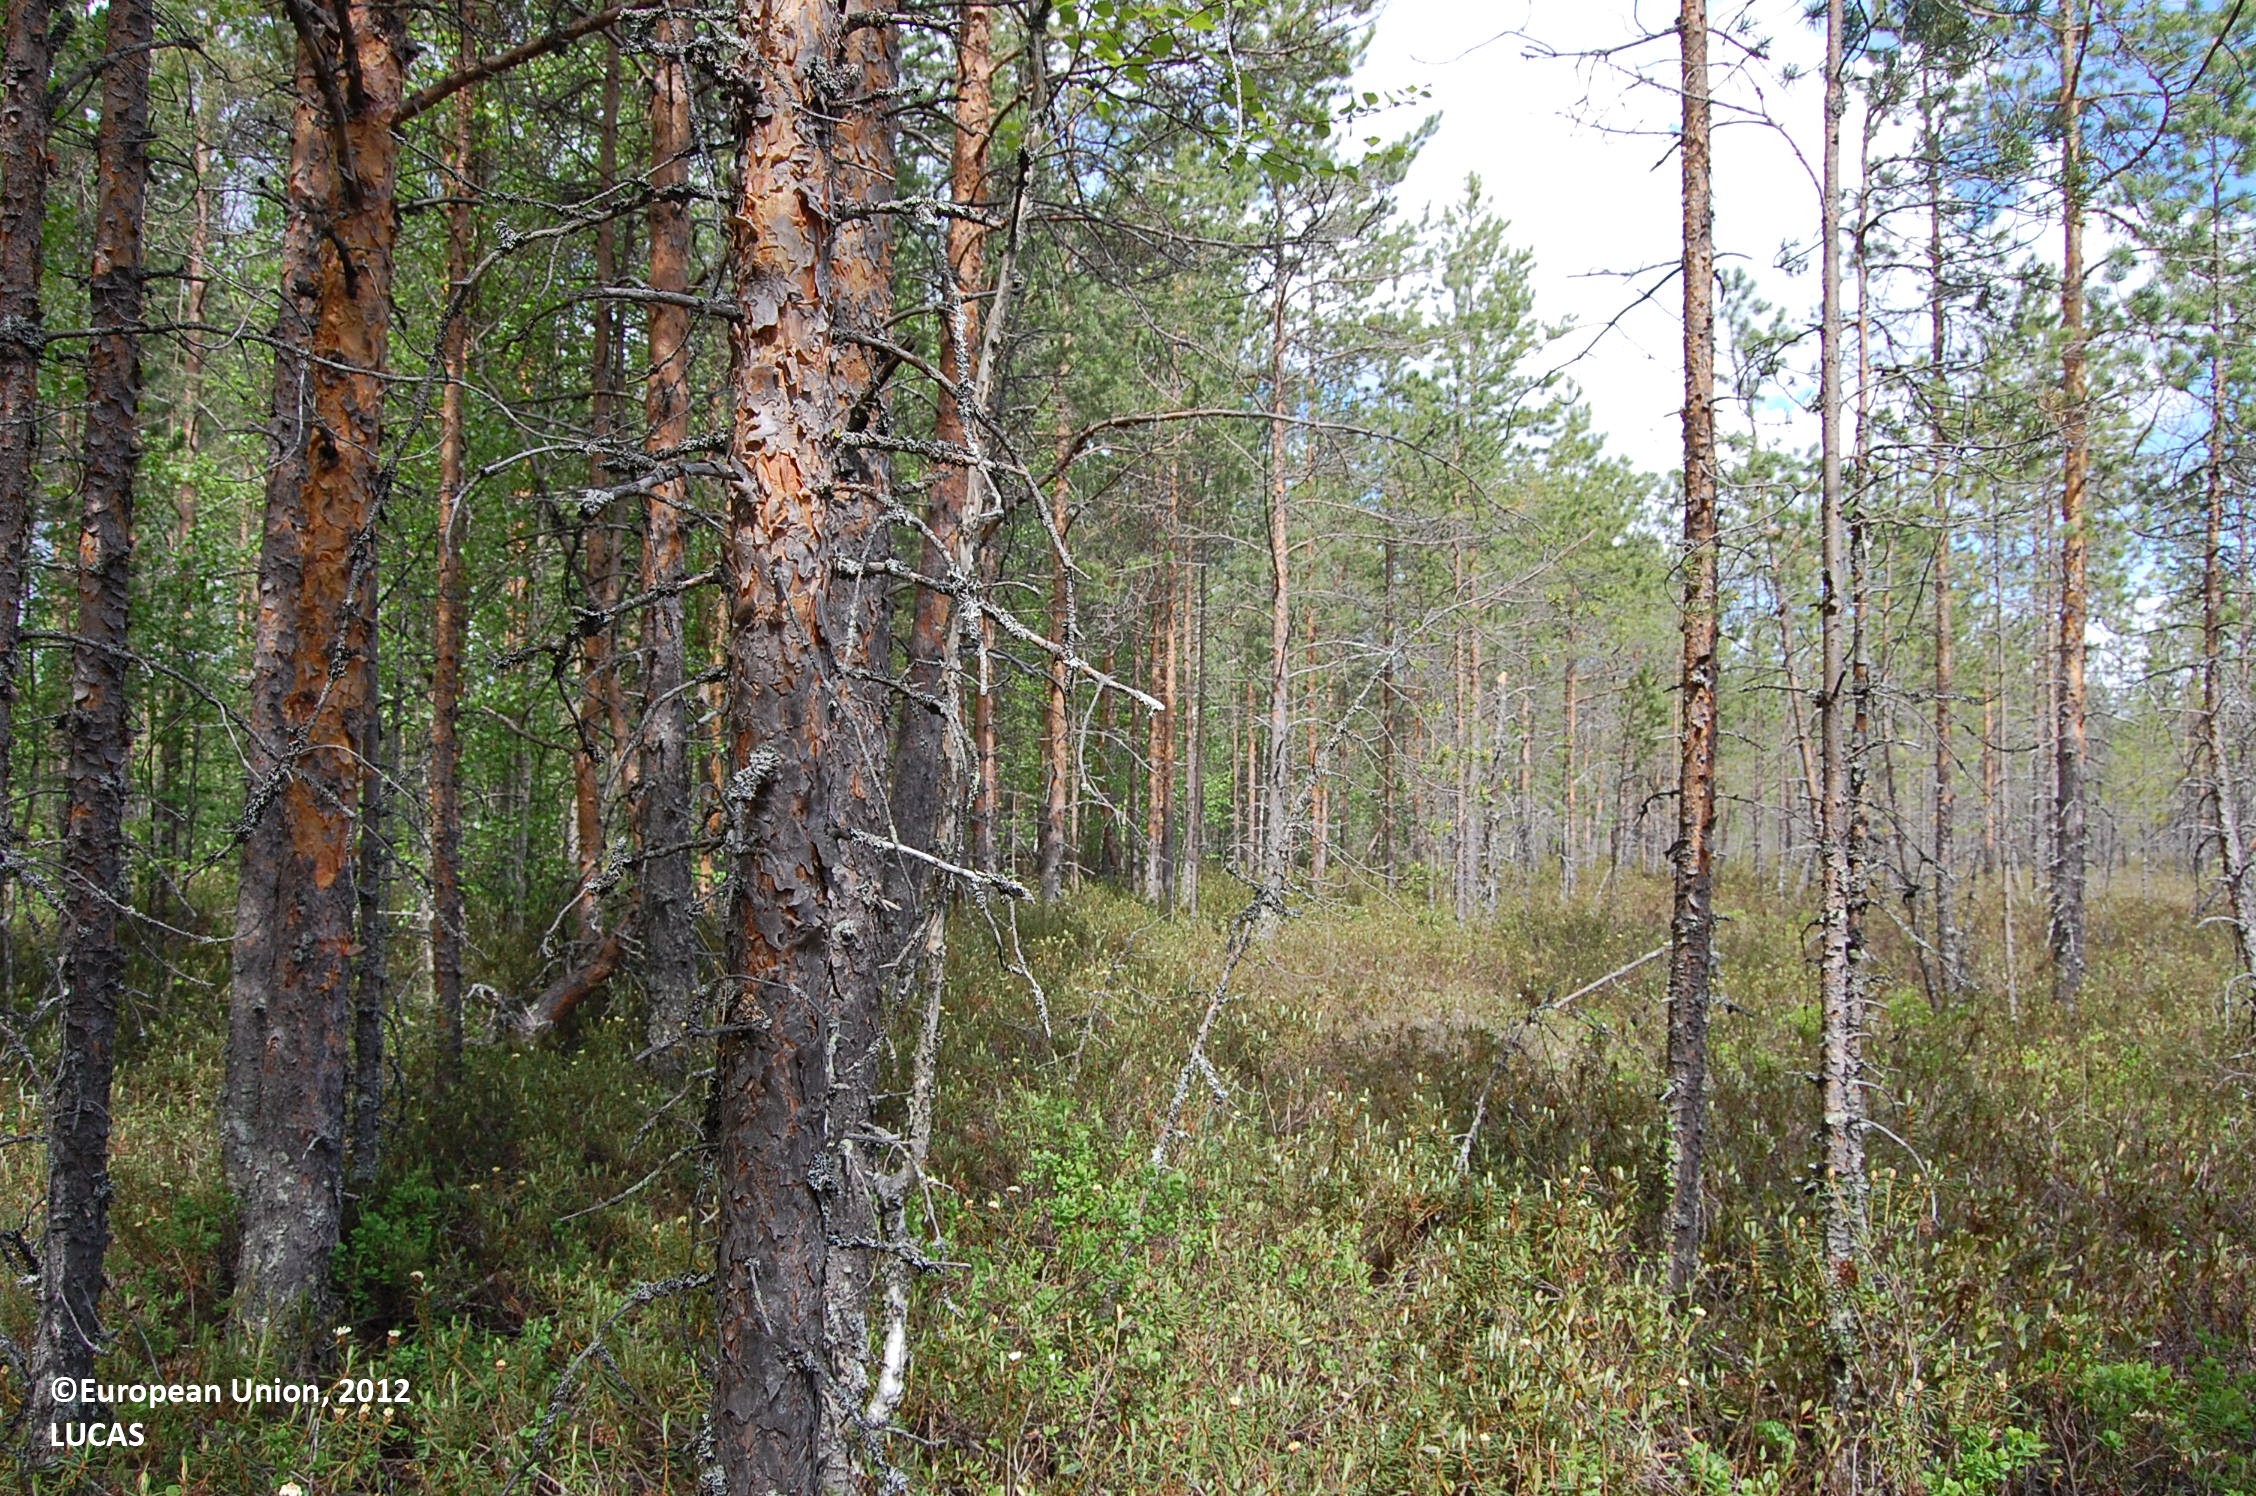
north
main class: Woodland
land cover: Pine dominated coniferous woodland
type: hemiboreal forest and nemoral coniferous forest and mixed broadleaved-coniferous forest
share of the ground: > 75 %
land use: Forestry
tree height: > 5 m
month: June
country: FI
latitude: 64.1278
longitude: 26.2358
